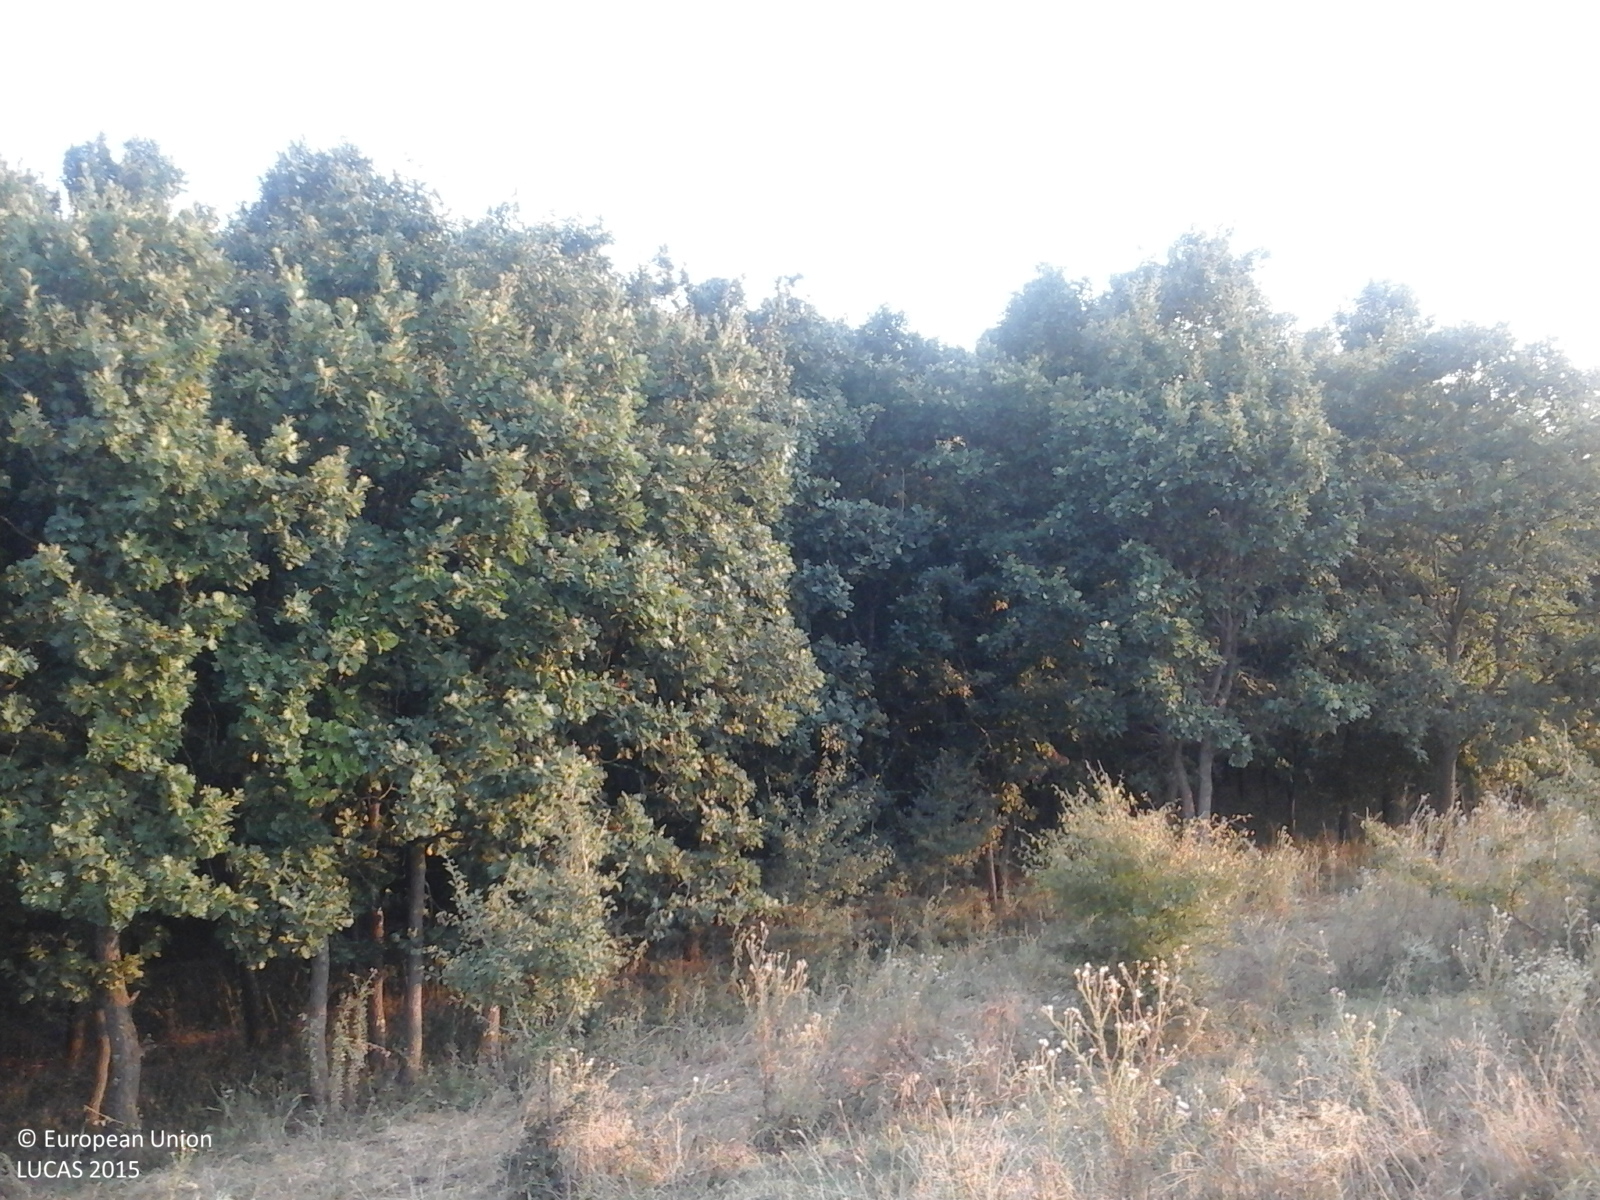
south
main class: Grassland
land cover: Grassland with sparse tree/shrub cover
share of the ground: > 75 %
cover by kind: herbaceous plants 85 %, shrubs 10 %, broadleaved forest trees 5 %
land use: Agriculture (excluding fallow land and kitchen gardens)
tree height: < 5 m
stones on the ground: < 10 %
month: August
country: RO
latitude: 44.3195
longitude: 23.6586
